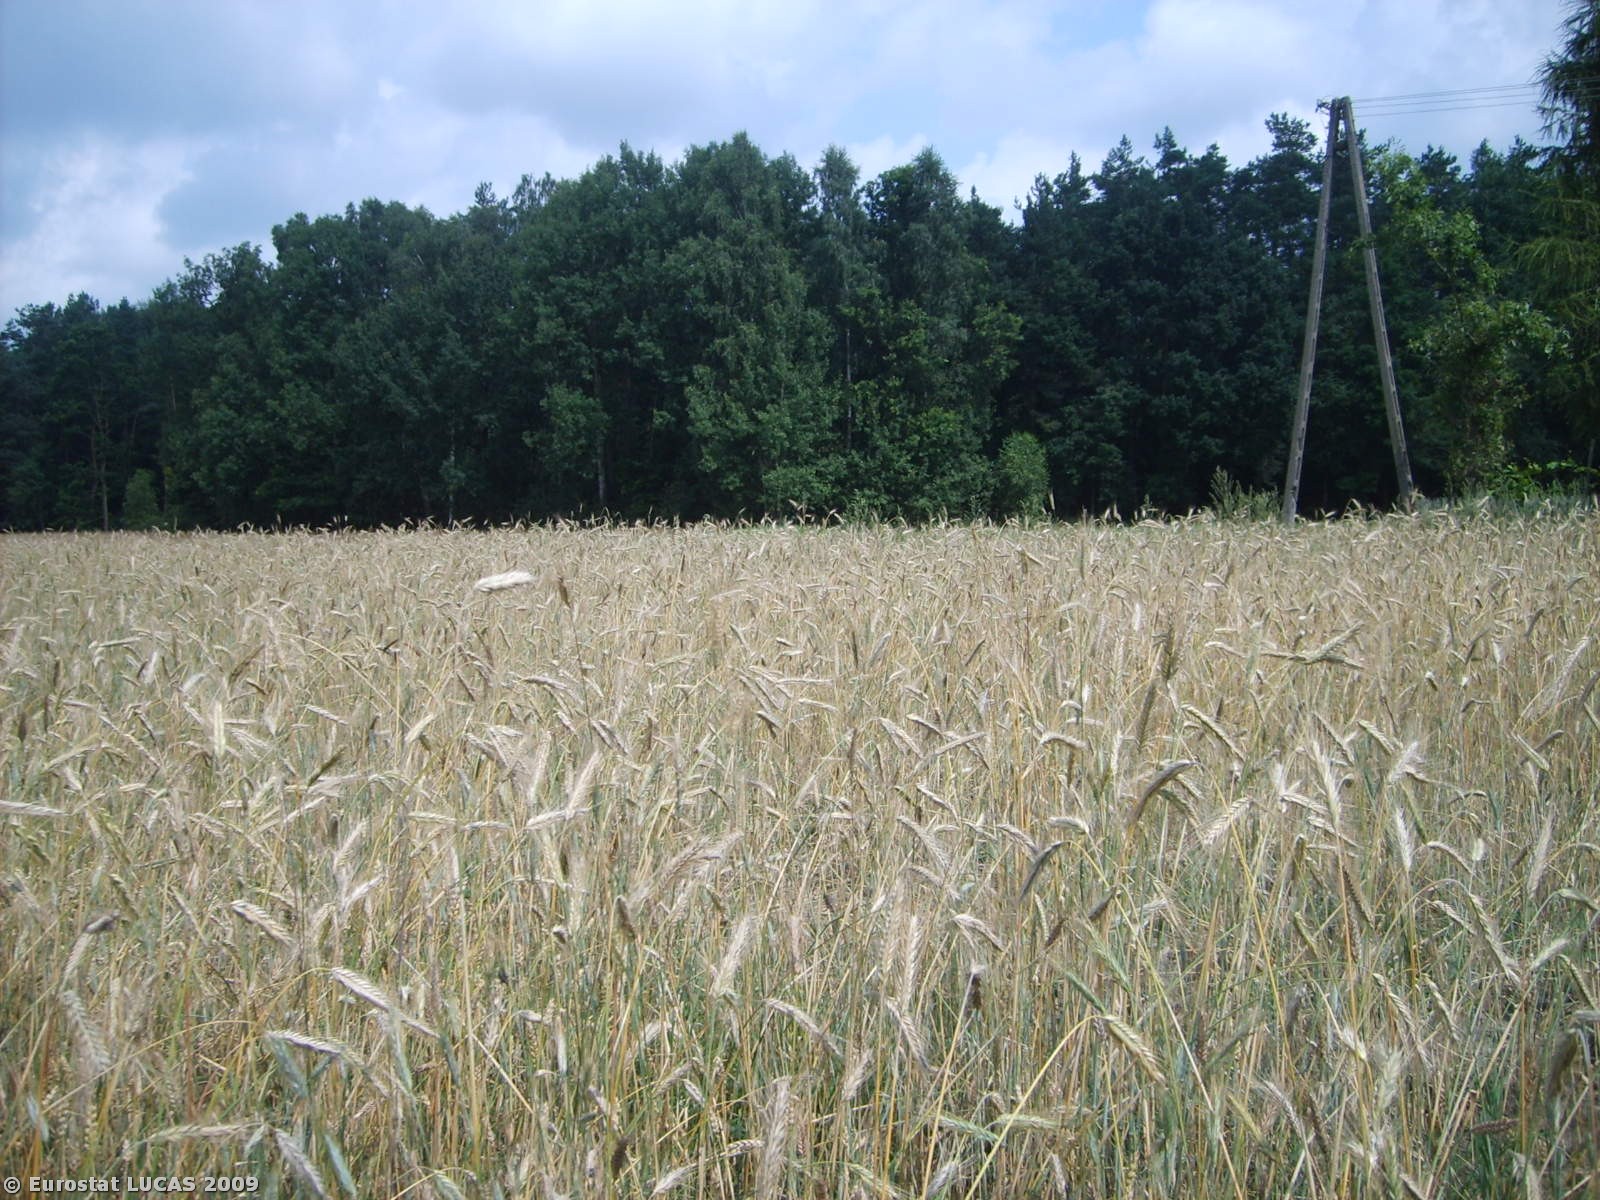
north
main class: Cropland
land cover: Rye
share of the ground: > 75 %
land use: Agriculture (excluding fallow land and kitchen gardens)
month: July
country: PL
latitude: 52.1242
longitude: 21.6951
